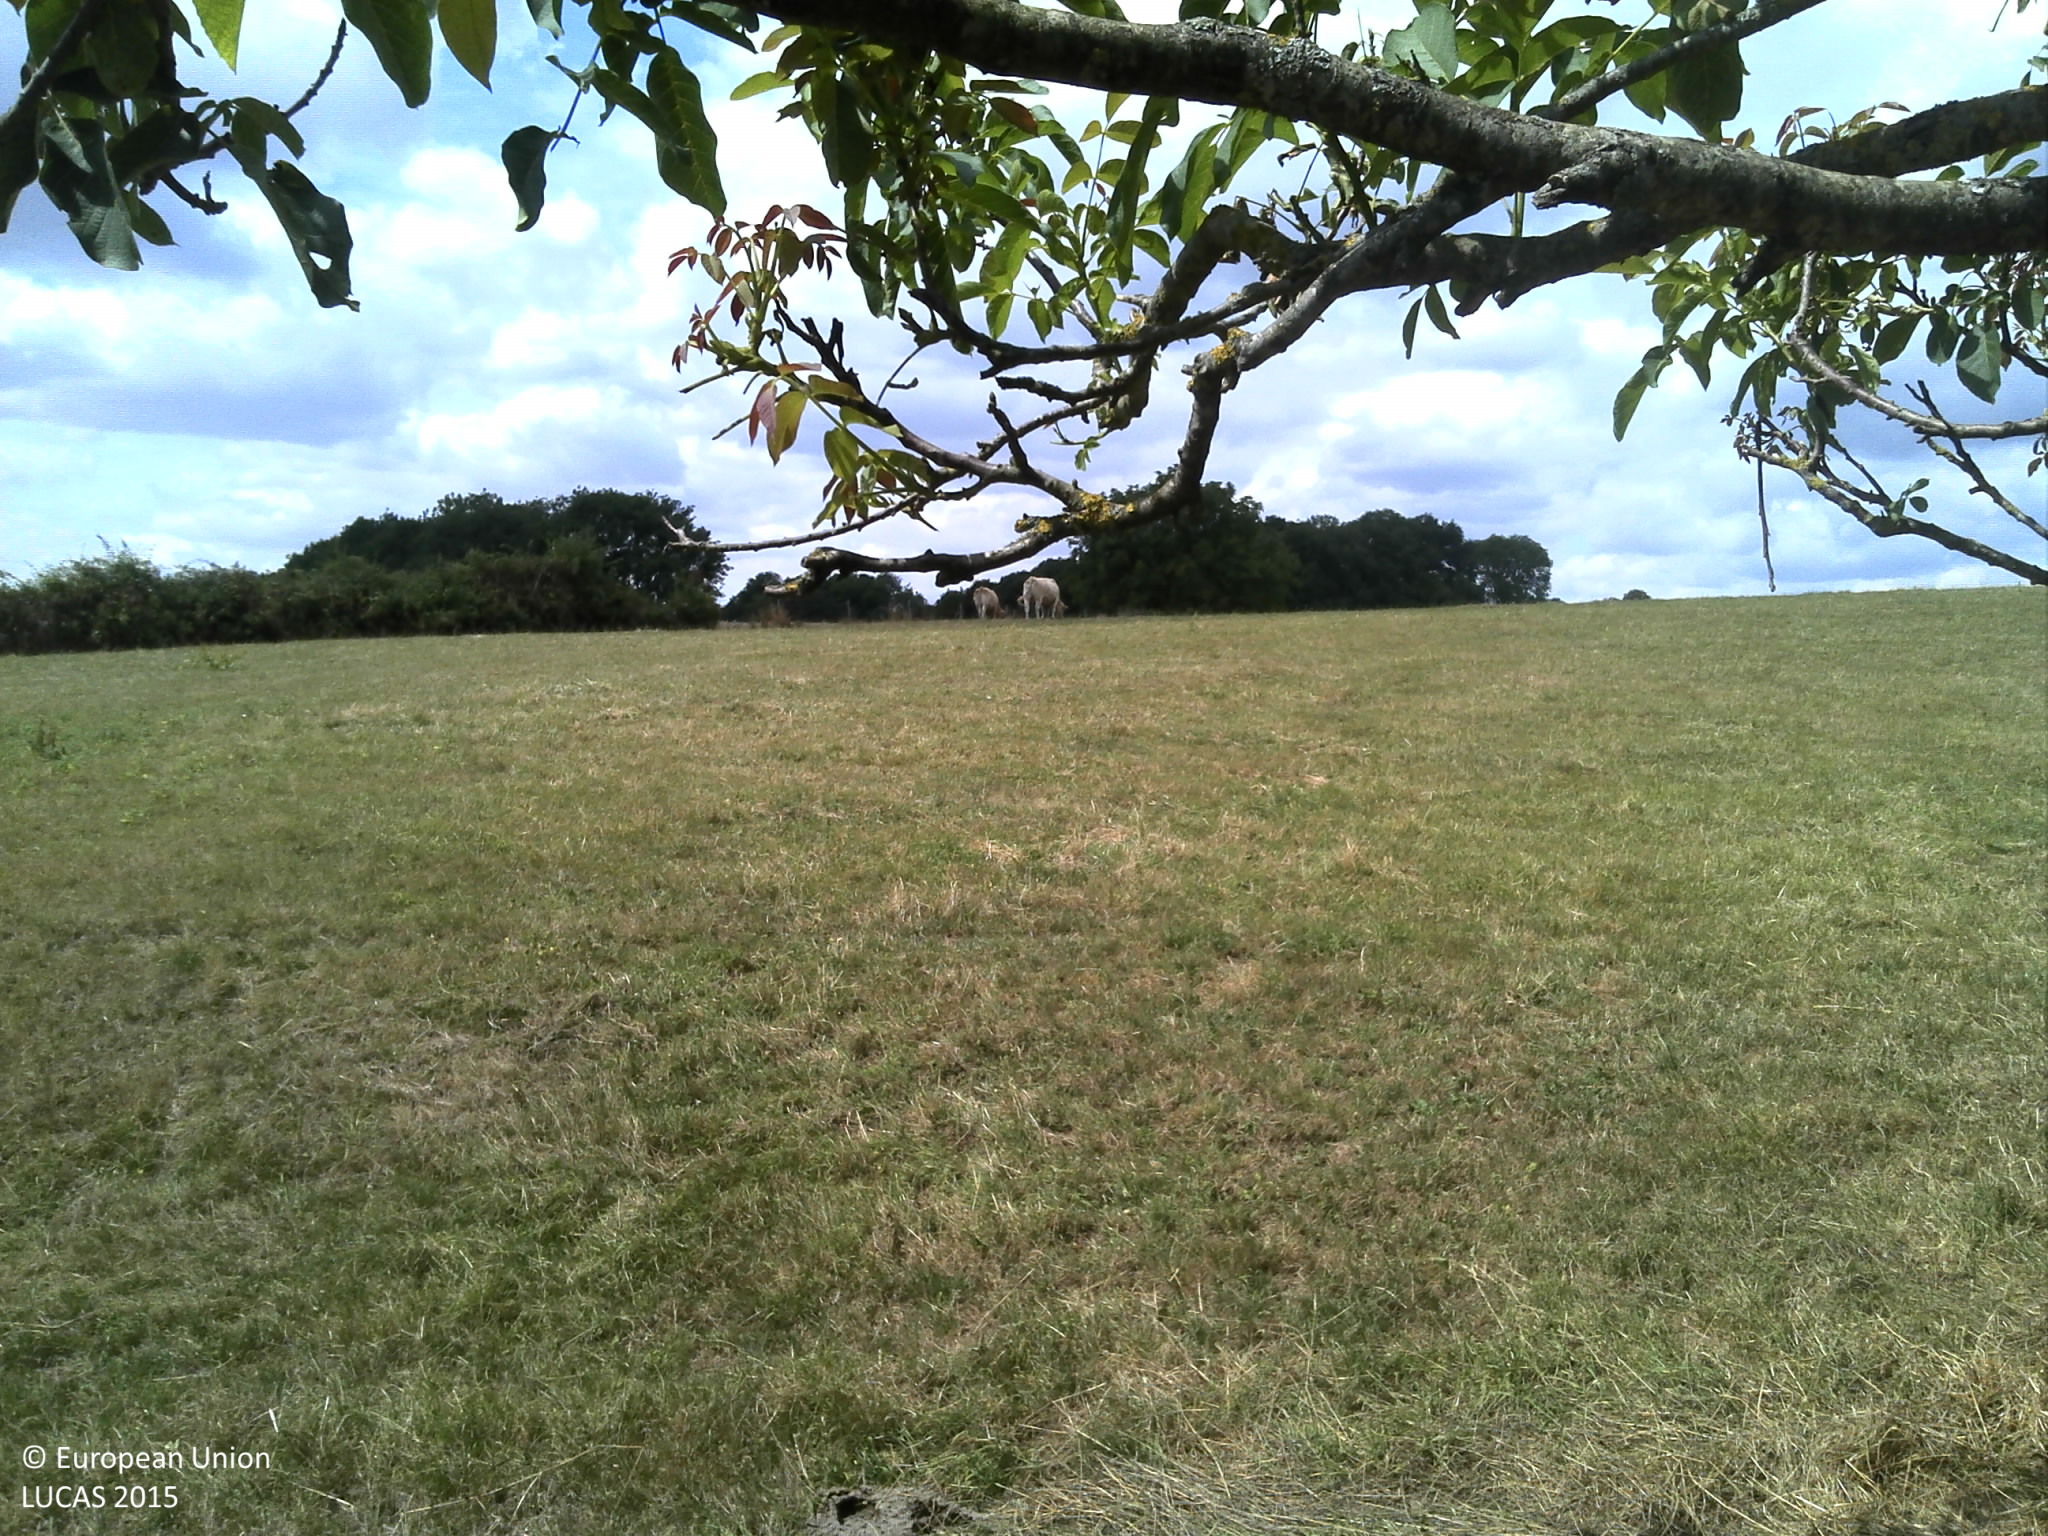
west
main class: Grassland
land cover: Grassland with sparse tree/shrub cover
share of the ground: > 75 %
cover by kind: herbaceous plants 95 %, broadleaved forest trees 5 %
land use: Agriculture (excluding fallow land and kitchen gardens)
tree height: > 5 m
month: July
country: FR
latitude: 49.6176
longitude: 4.4734
